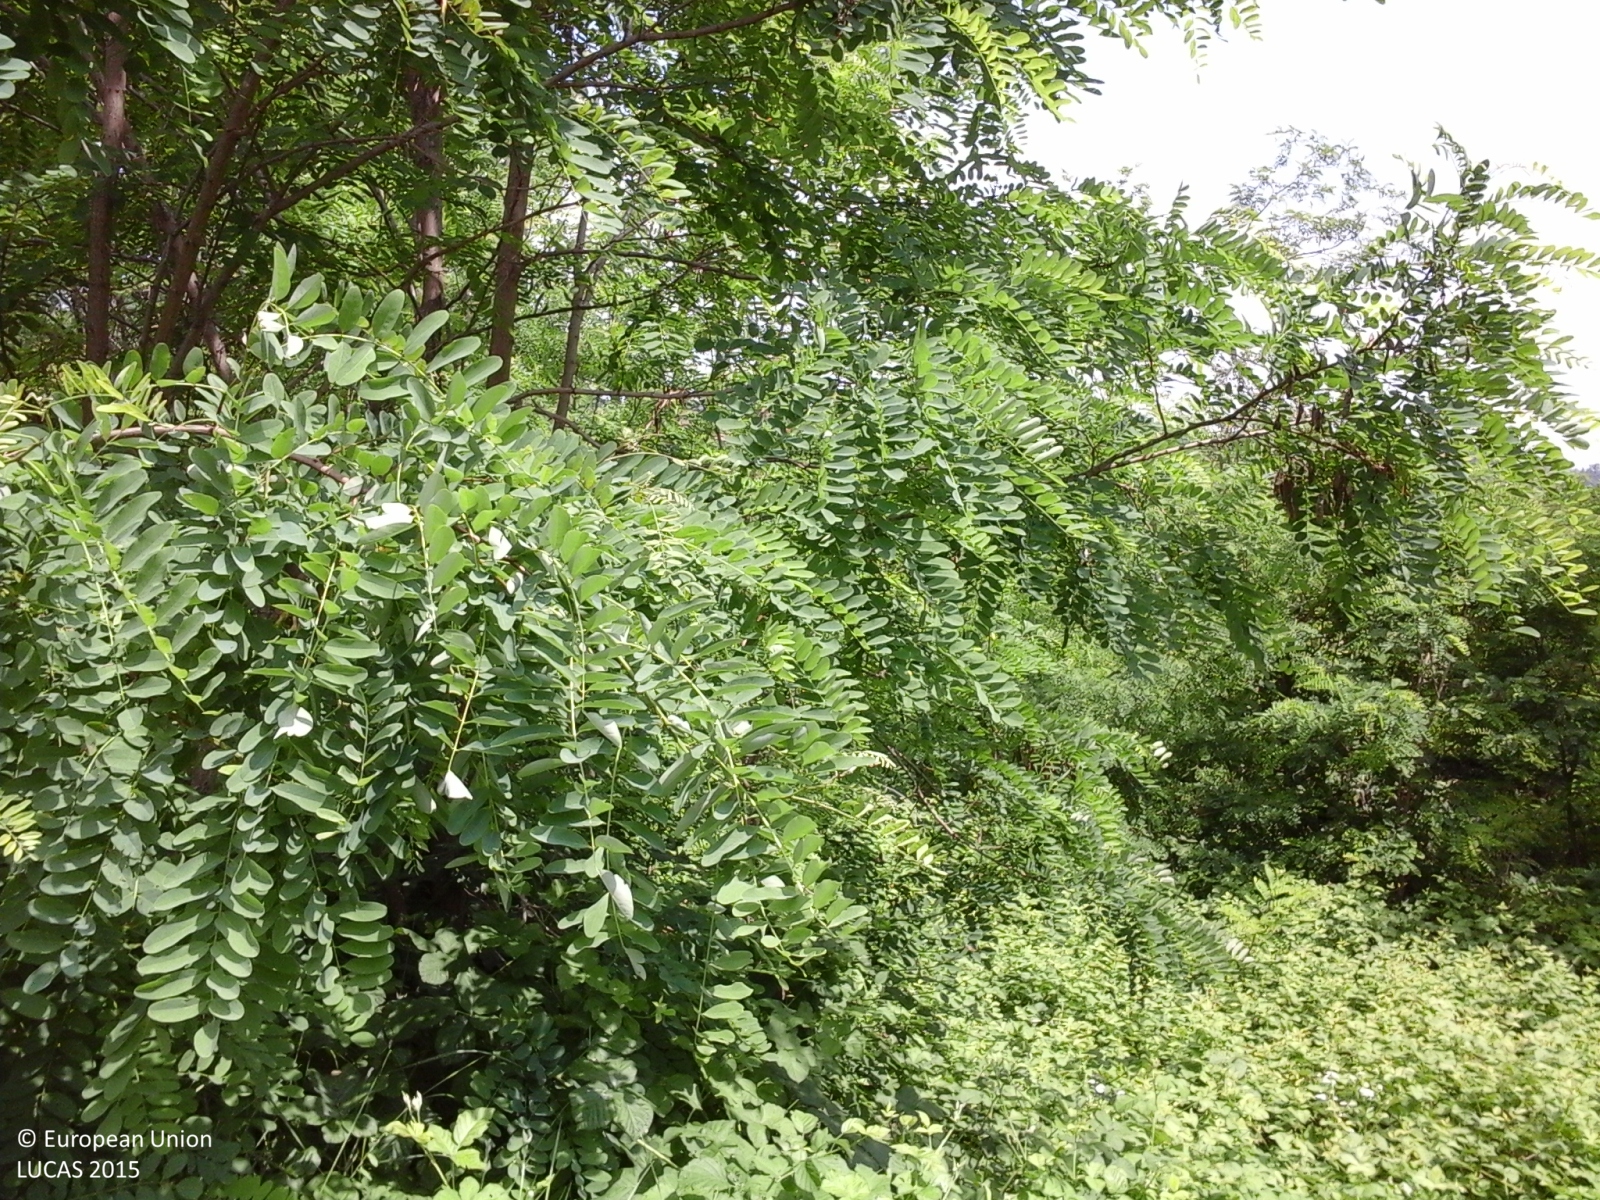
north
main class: Shrubland
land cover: Shrubland with sparse tree cover
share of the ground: > 75 %
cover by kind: shrubs 95 %, broadleaved forest trees 5 %
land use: Semi-natural and natural areas not in use
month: June
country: IT
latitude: 44.8550
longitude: 9.6843
